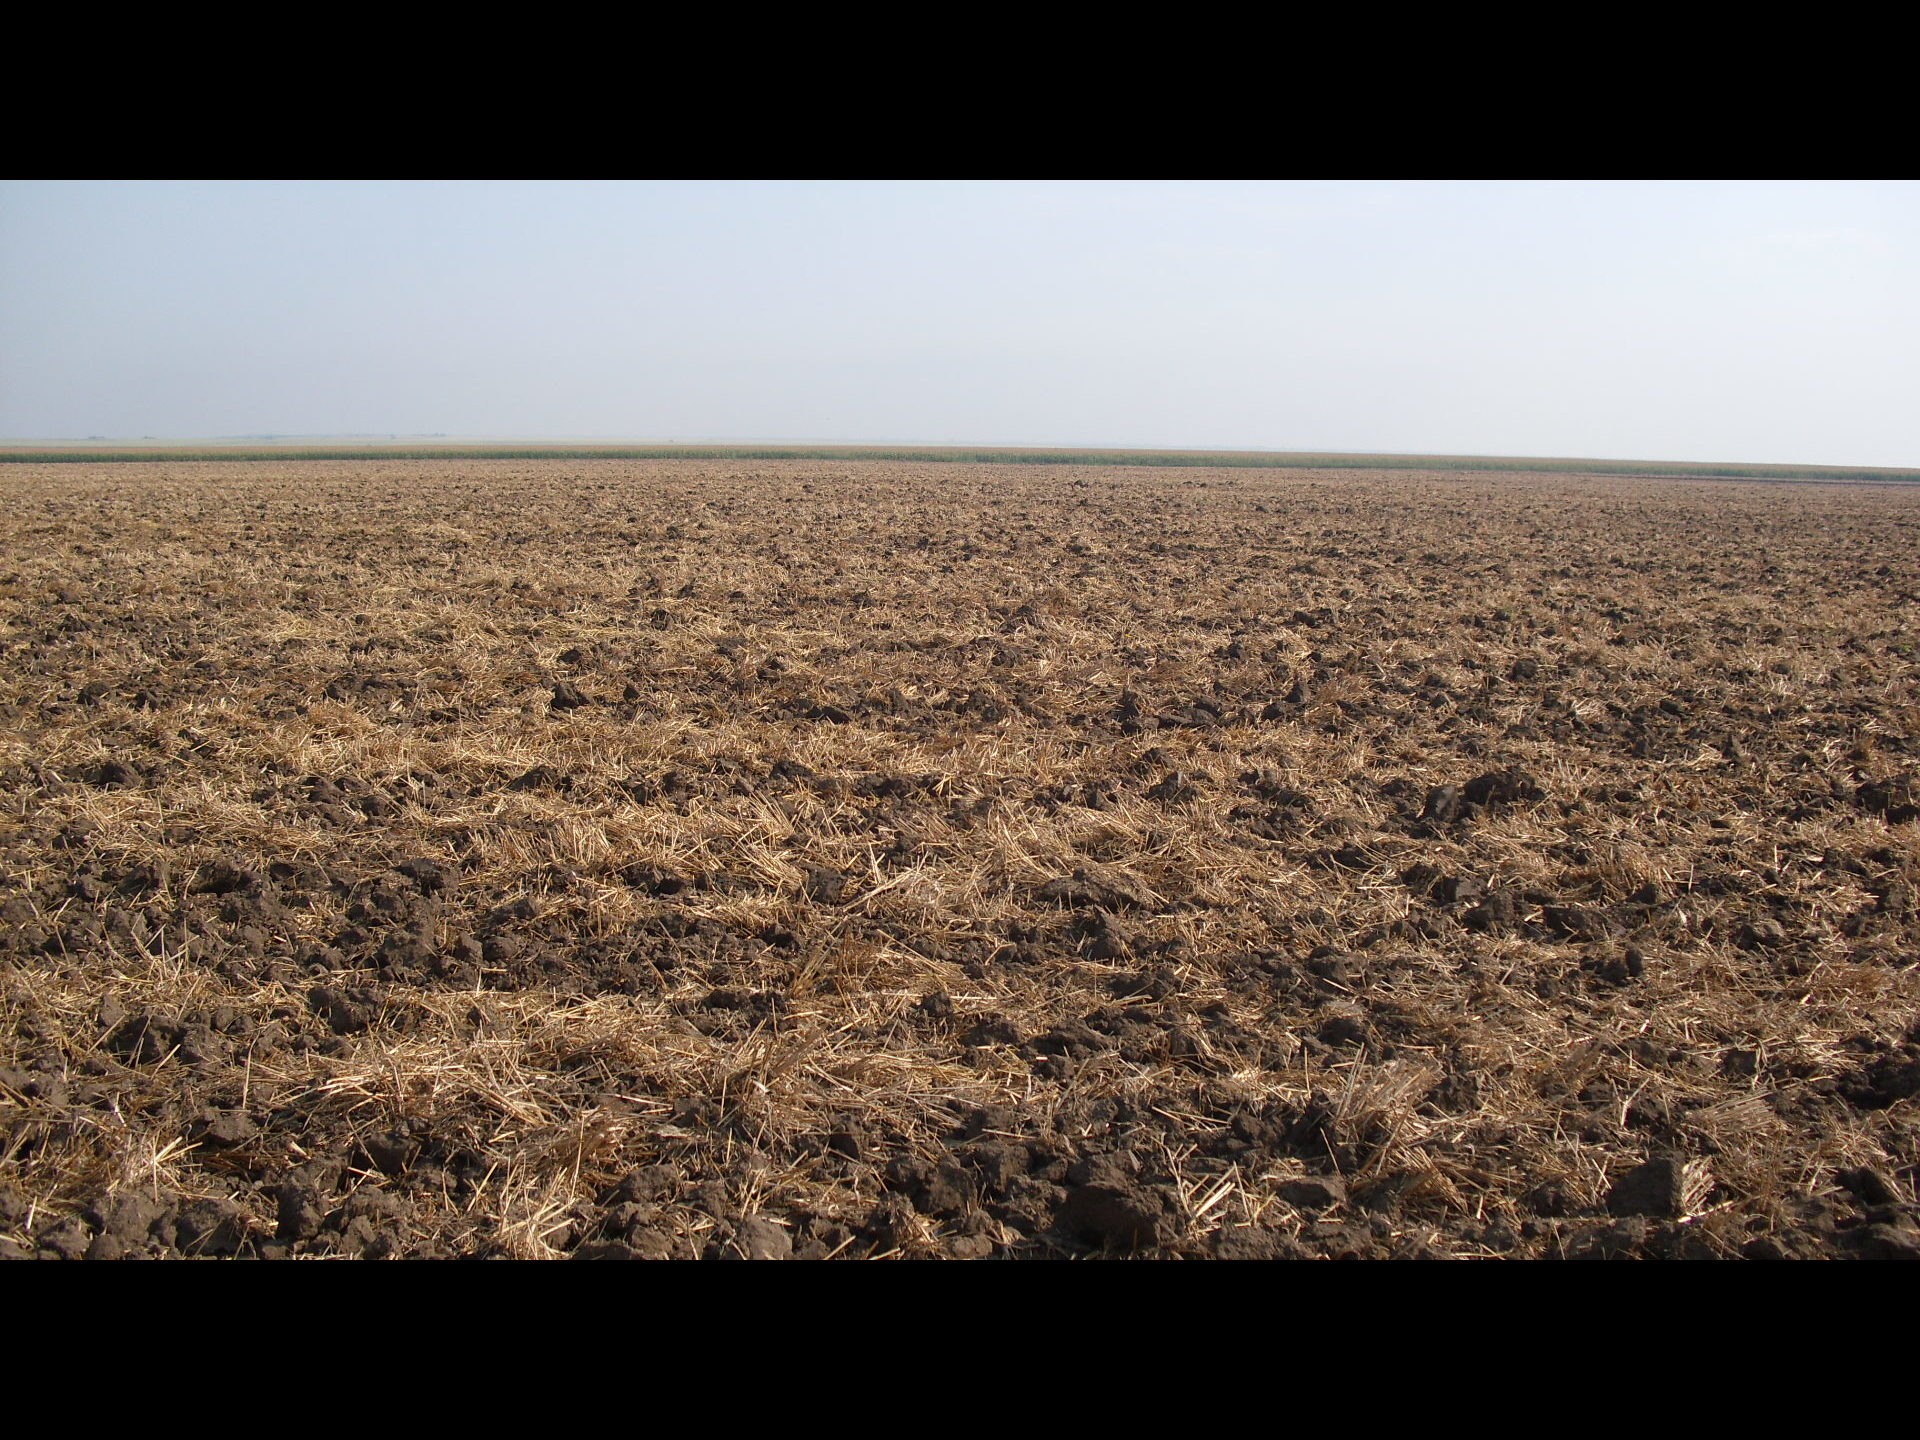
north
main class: Cropland
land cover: Barley
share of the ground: 50 - 75 %
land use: Agriculture (excluding fallow land and kitchen gardens)
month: July
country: BG
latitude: 43.7176
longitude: 23.5140
